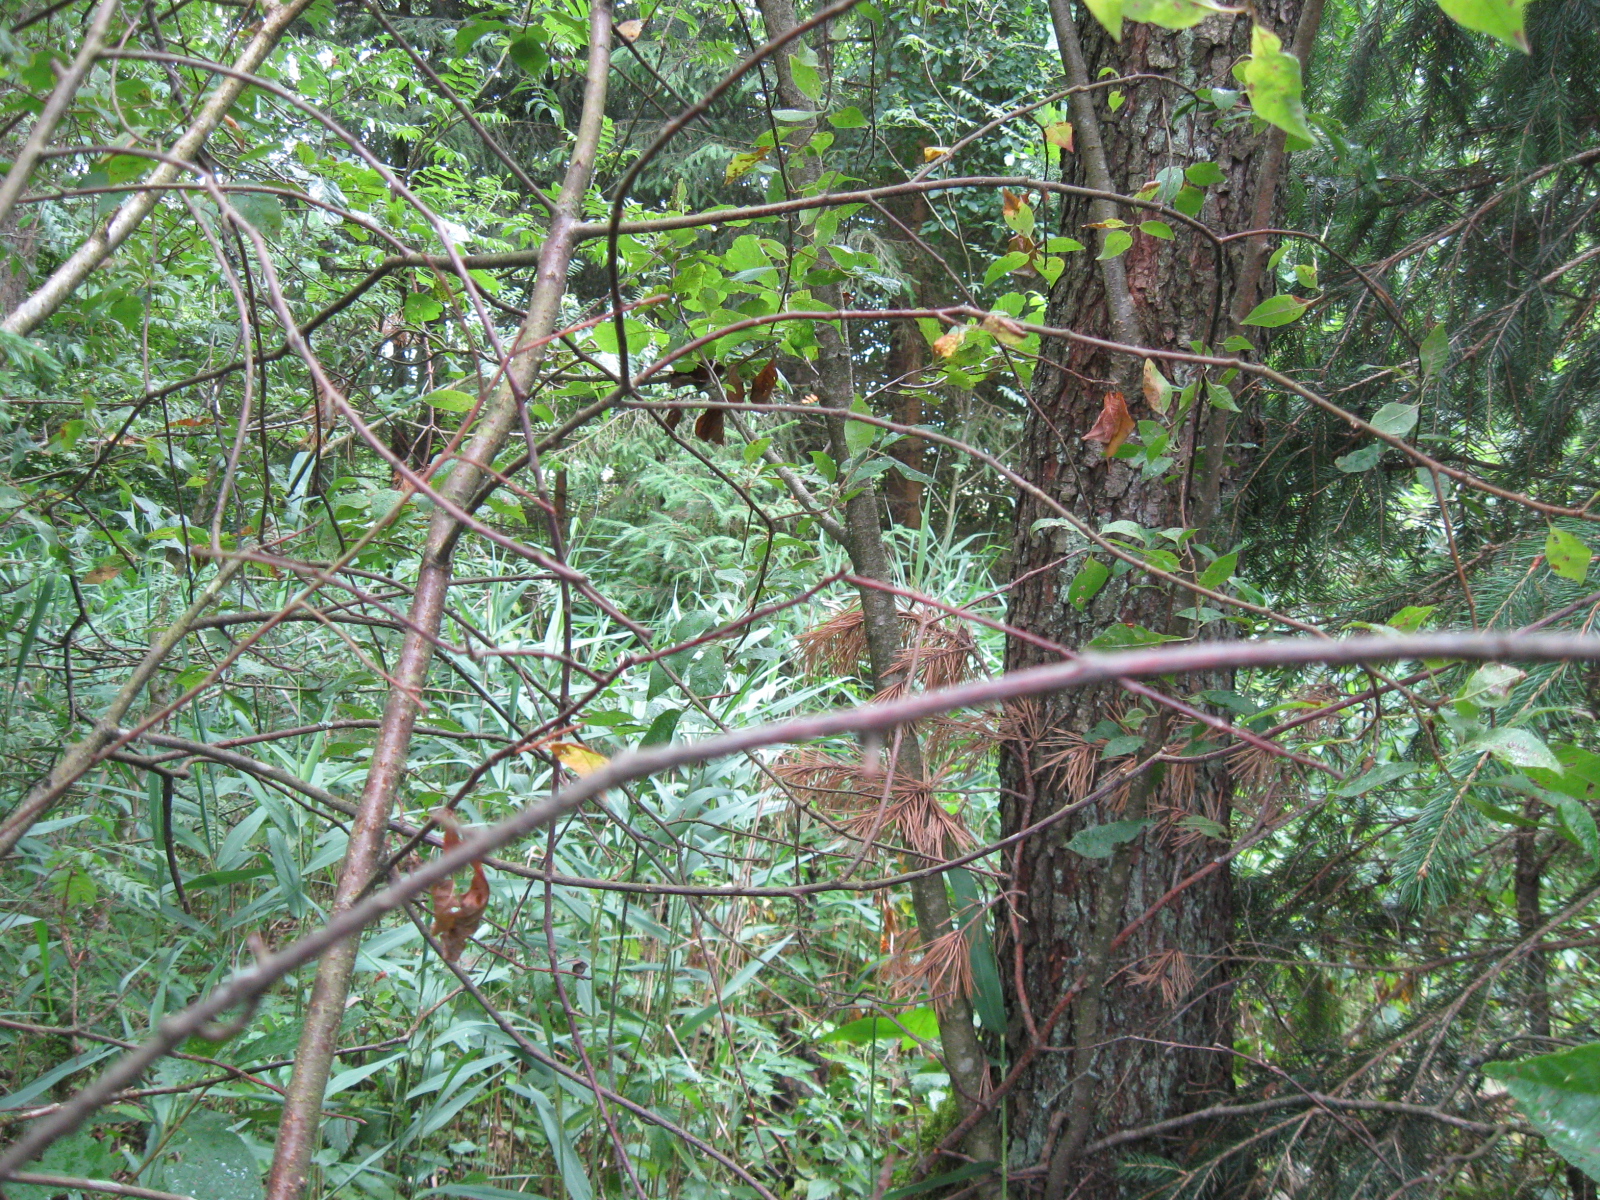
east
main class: Woodland
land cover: Other mixed woodland
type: mire and swamp forests
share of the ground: > 75 %
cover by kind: broadleaved forest trees 50 %, coniferous forest trees 35 %, shrubs 10 %, herbaceous plants 5 %
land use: Forestry
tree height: > 5 m
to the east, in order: Other mixed woodland; Broadleaved woodland; Ditches and canals; Grassland without tree/shrub cover; Other cereals
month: July
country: LT
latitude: 54.2969
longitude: 24.3435
